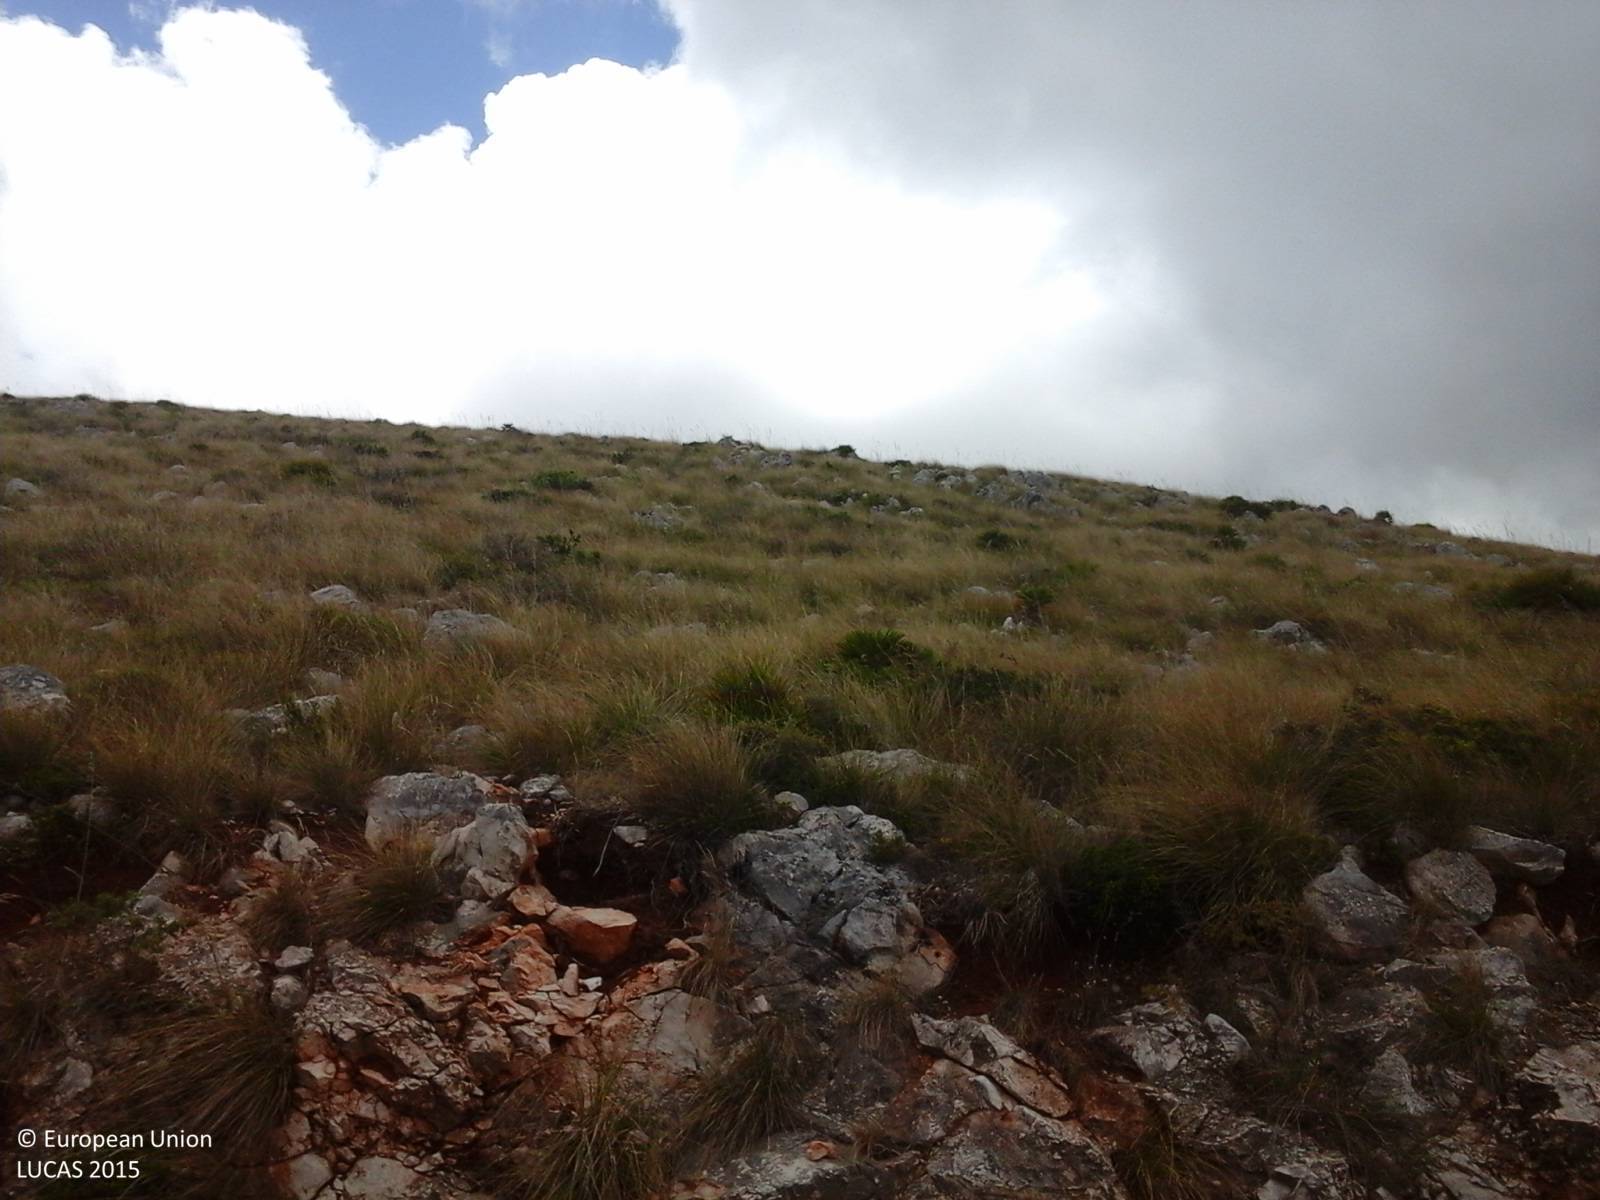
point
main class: Grassland
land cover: Grassland without tree/shrub cover
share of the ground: > 75 %
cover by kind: herbaceous plants 100 %
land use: Semi-natural and natural areas not in use
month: June
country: IT
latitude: 38.1429
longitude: 12.7759
